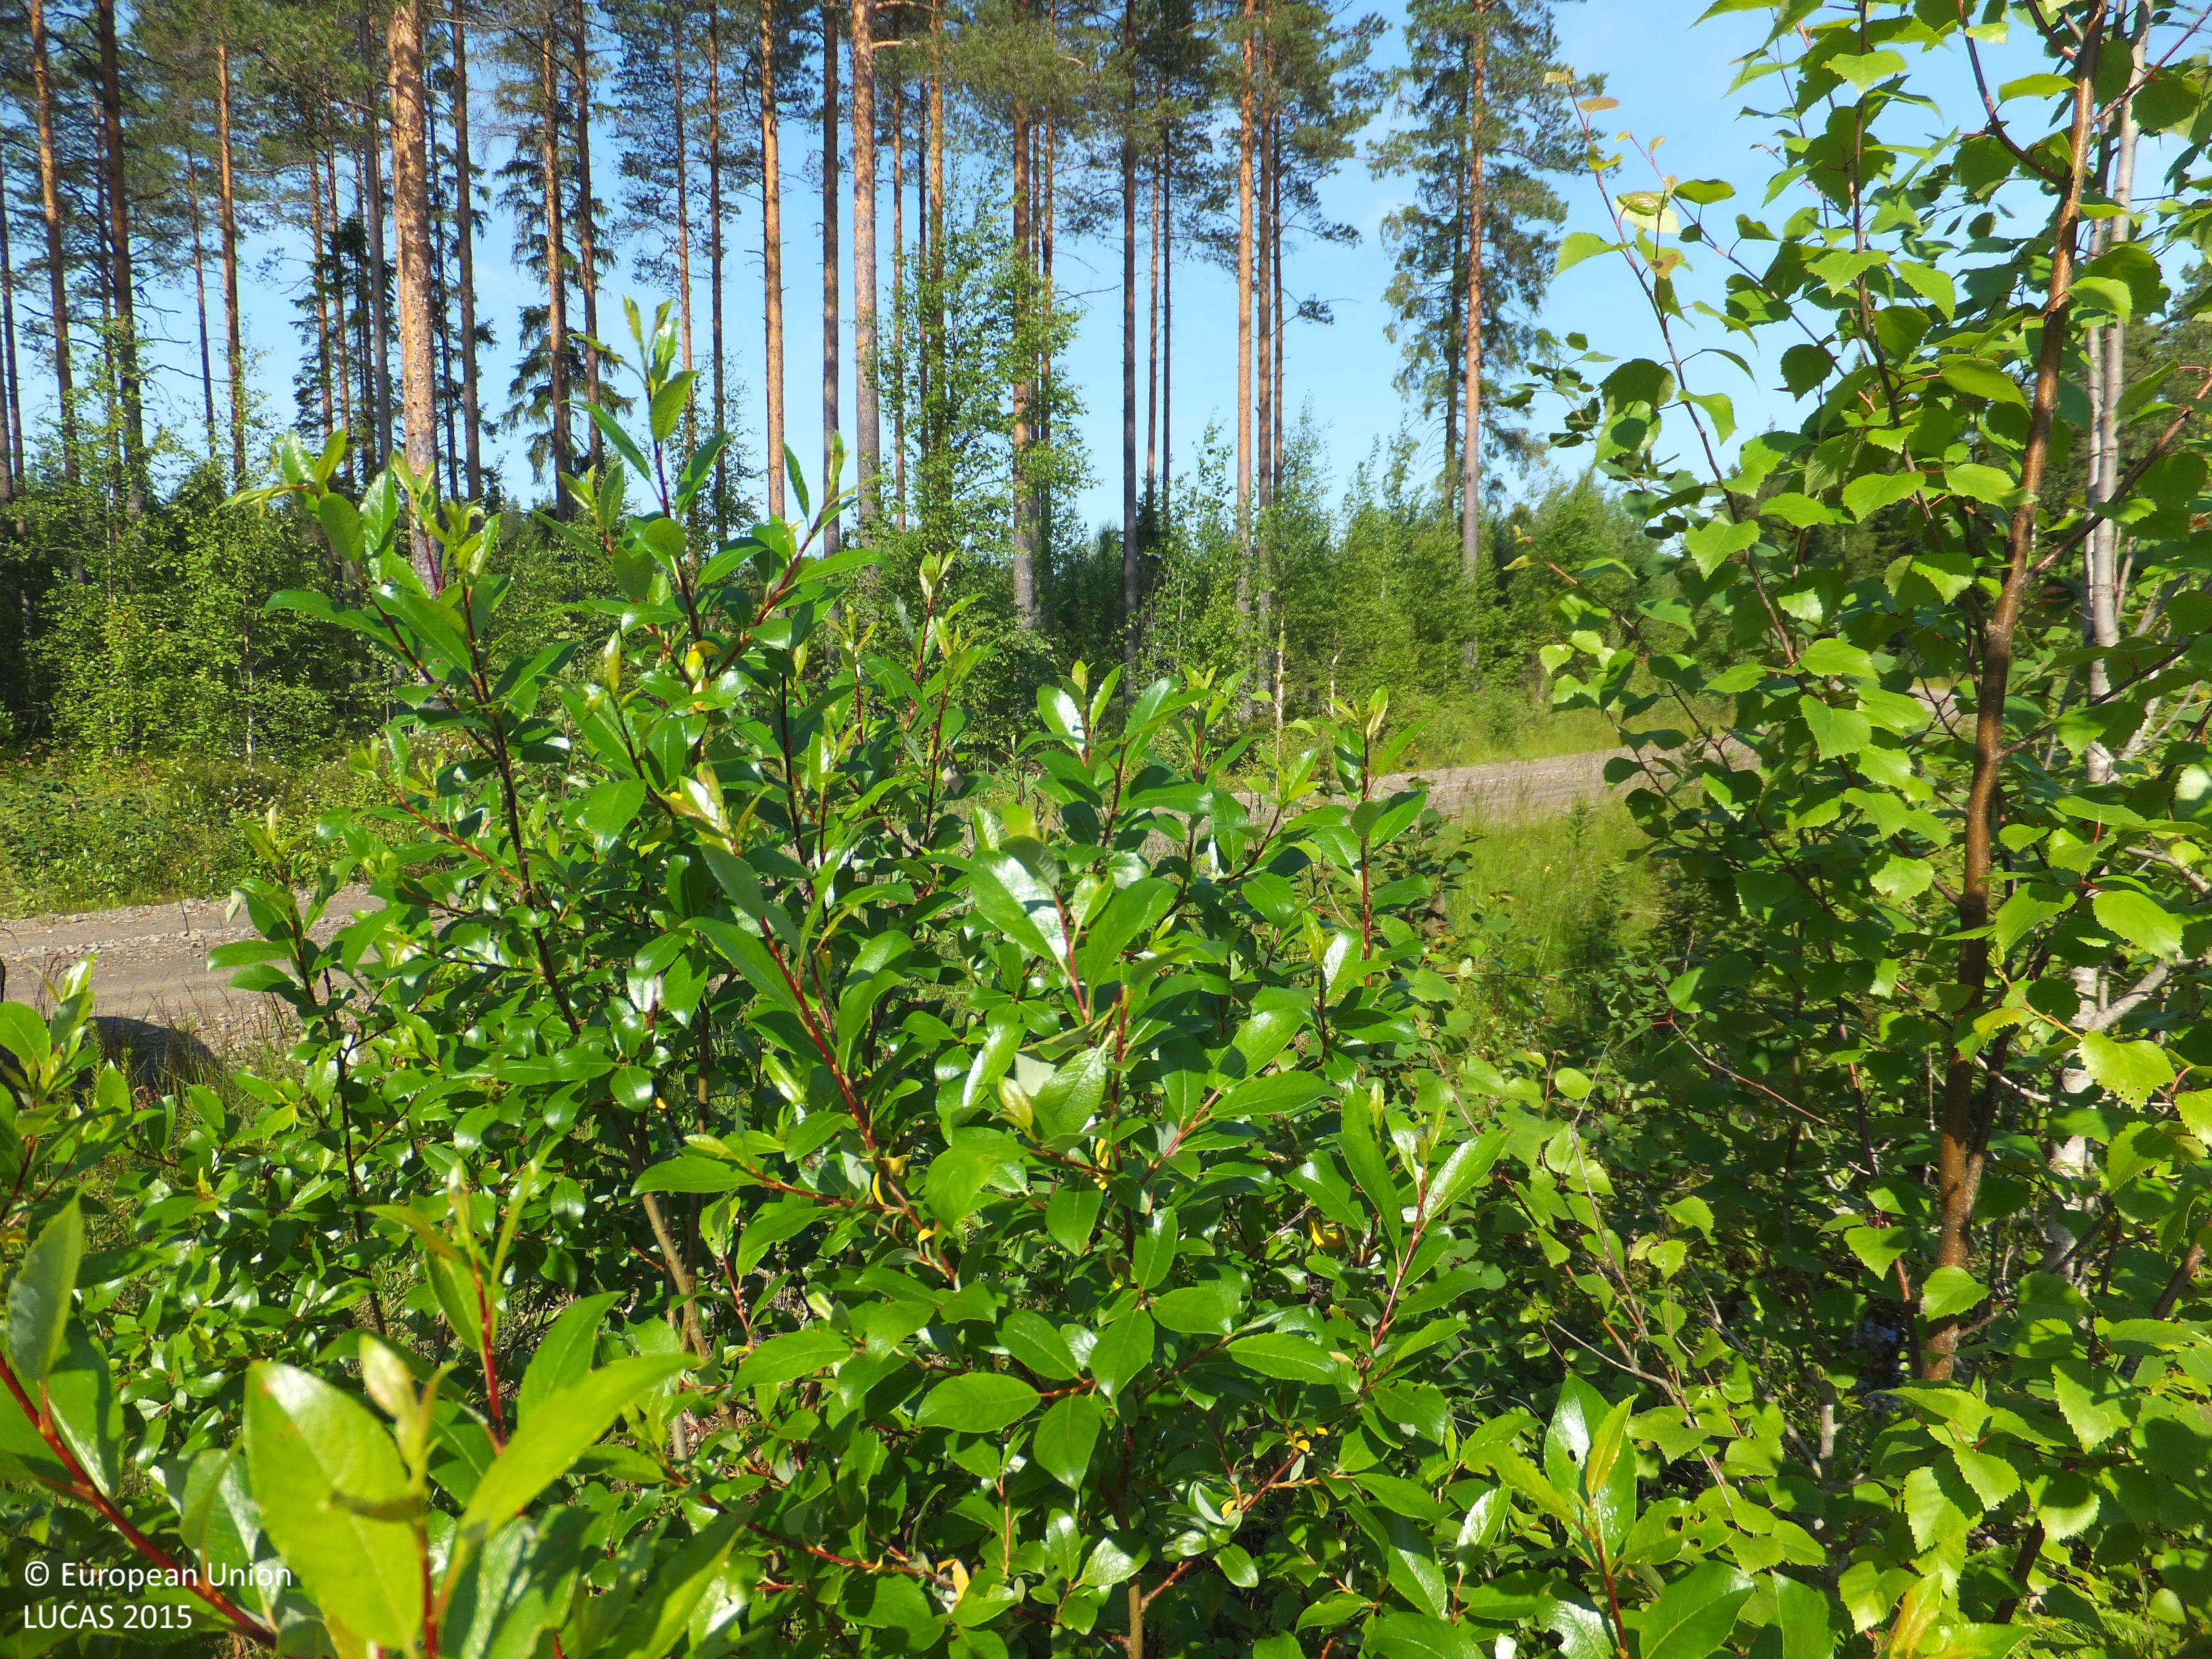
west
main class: Woodland
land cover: Pine dominated mixed woodland
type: boreal forest
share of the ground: 25 - 50 %
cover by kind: coniferous forest trees 20 %, broadleaved forest trees 20 %, herbaceous plants 20 %, unconsolidated bare surface 20 %, shrubs 10 %, lichens and mosses 10 %
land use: Forestry
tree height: < 5 m
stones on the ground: < 10 %
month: July
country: FI
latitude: 63.2977
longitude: 23.7720
